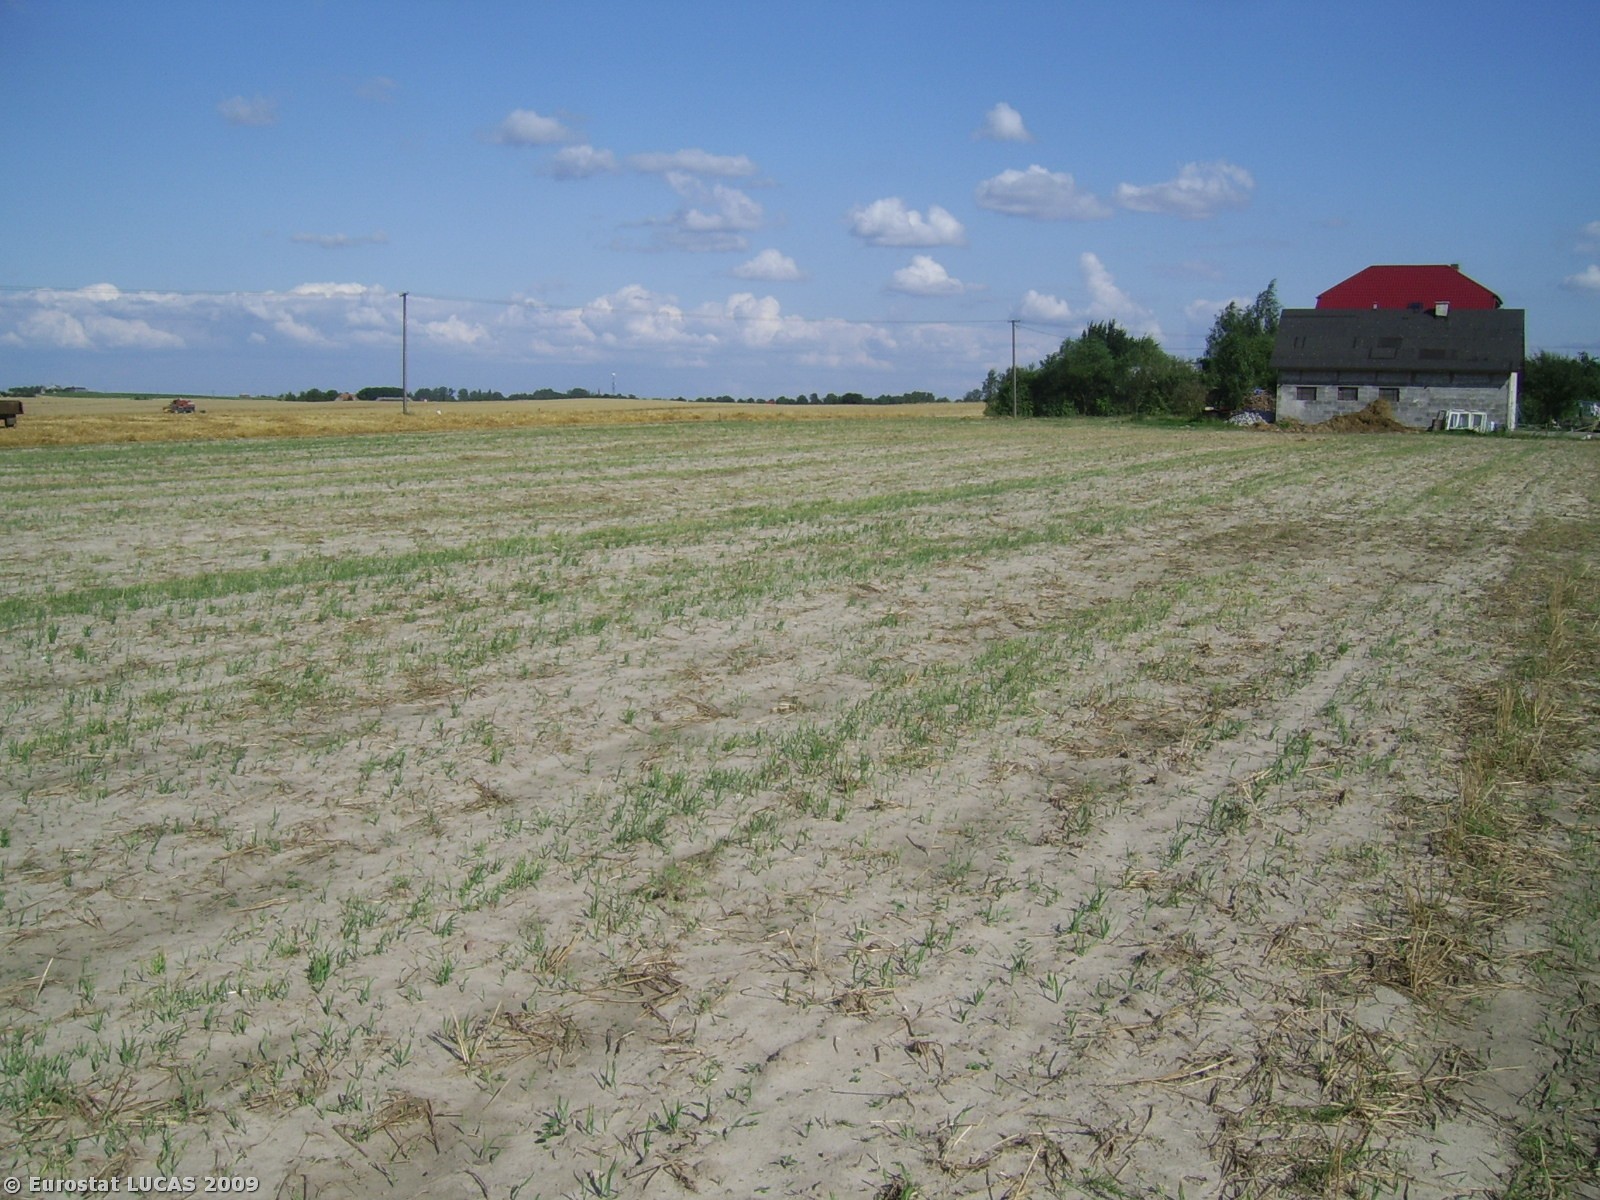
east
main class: Cropland
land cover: Barley
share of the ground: < 10 %
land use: Agriculture (excluding fallow land and kitchen gardens)
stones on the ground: < 10 %
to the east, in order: Barley; Common wheat; Electric lines; Common wheat; Grass margins; Tracks; Grass margins; Common wheat; Grass margins; Paved roads, cycling and walking lanes; Grass margins; Mixed cereals for fodder; Grass margins; Mixed cereals for fodder
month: August
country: PL
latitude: 53.1023
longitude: 18.7582
